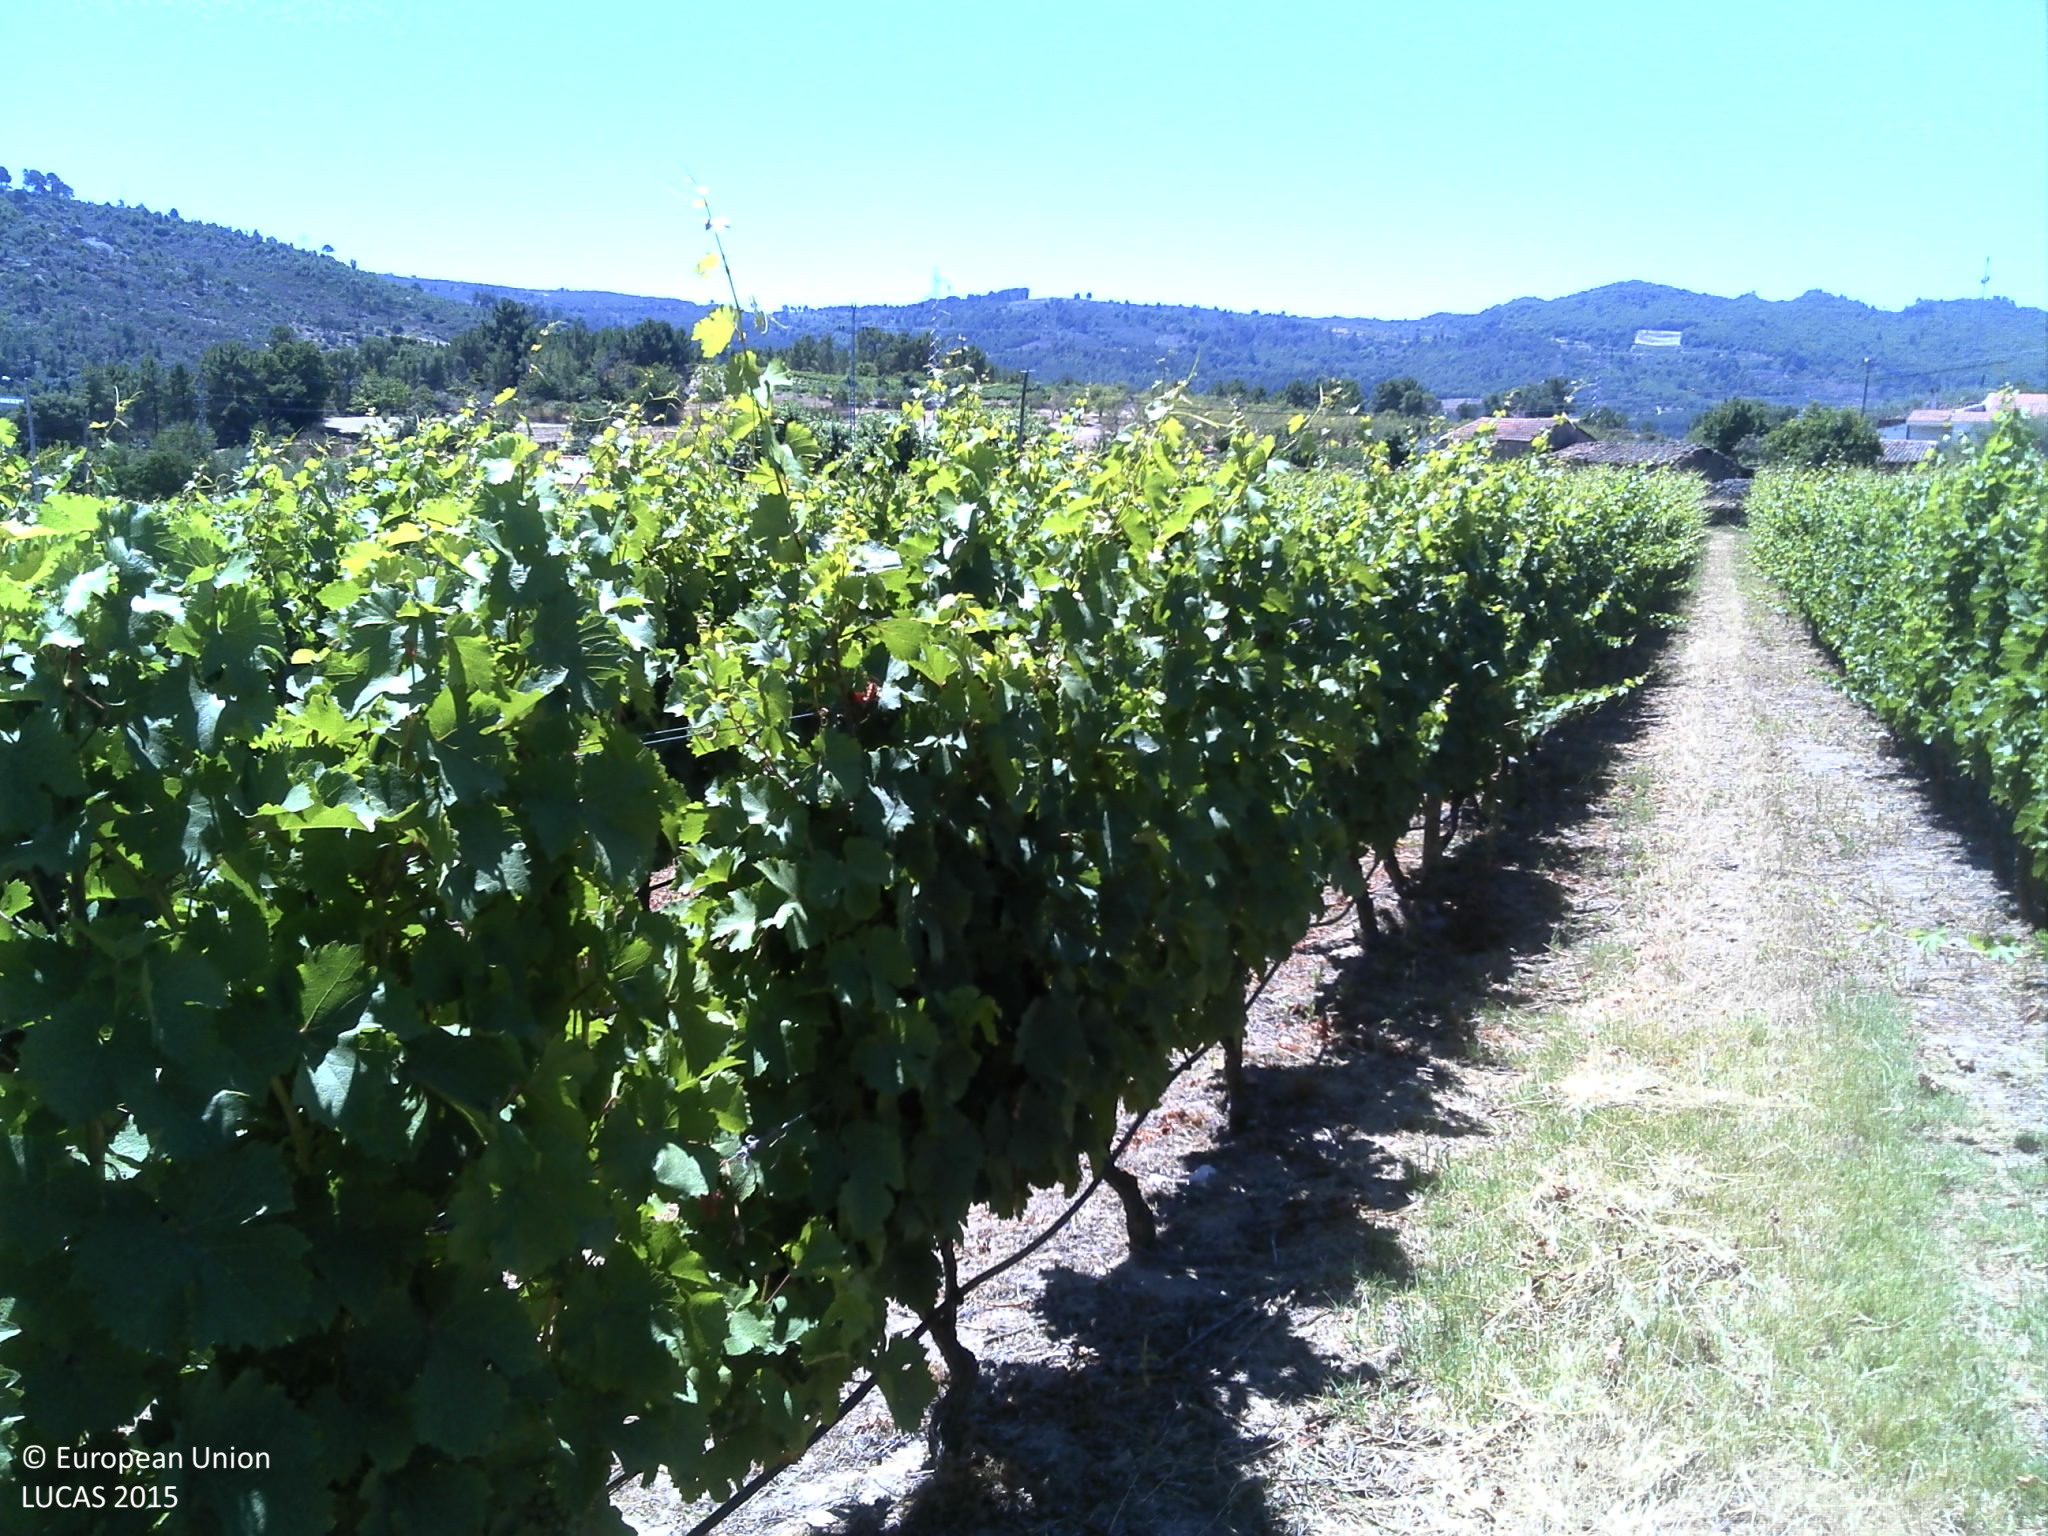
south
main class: Cropland
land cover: Vineyards
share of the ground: < 10 %
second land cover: Other bare soil
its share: > 75 %
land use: Agriculture (excluding fallow land and kitchen gardens)
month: July
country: PT
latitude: 41.2770
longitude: -7.3227
